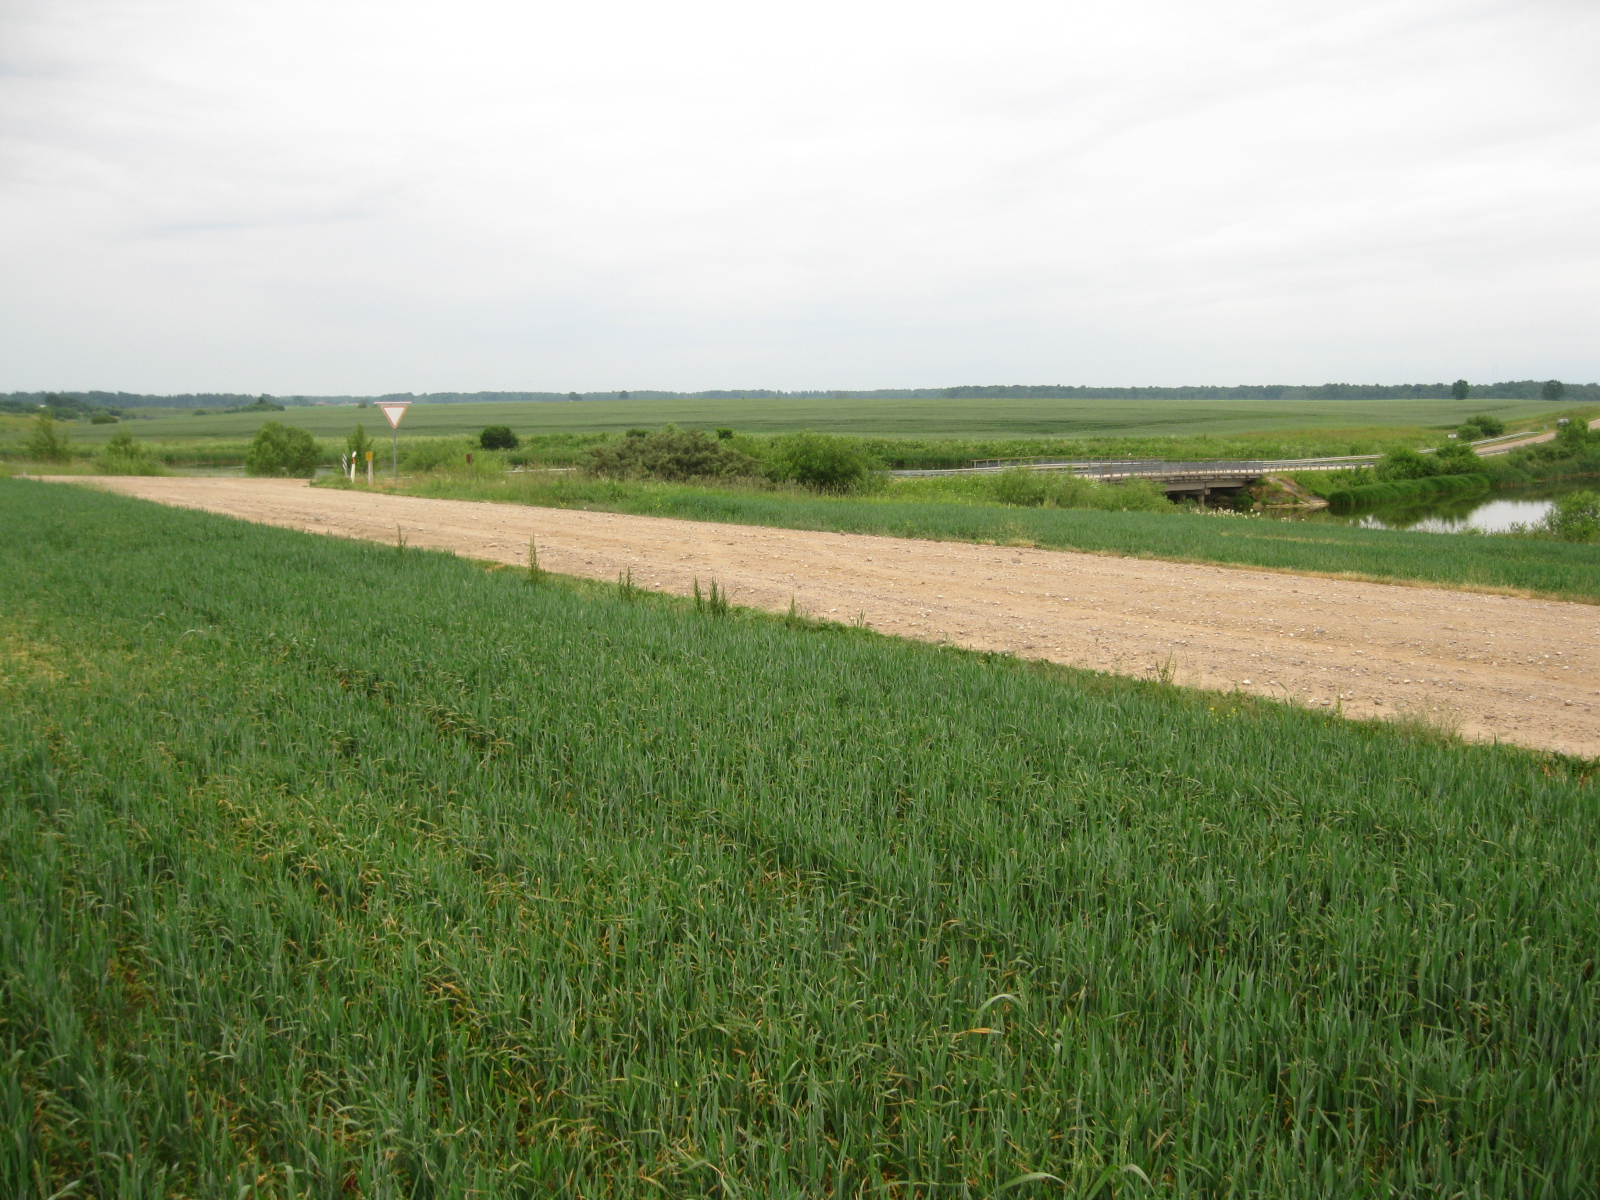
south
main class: Cropland
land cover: Common wheat
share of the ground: > 75 %
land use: Agriculture (excluding fallow land and kitchen gardens)
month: June
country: LT
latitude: 55.1189
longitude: 23.8699
